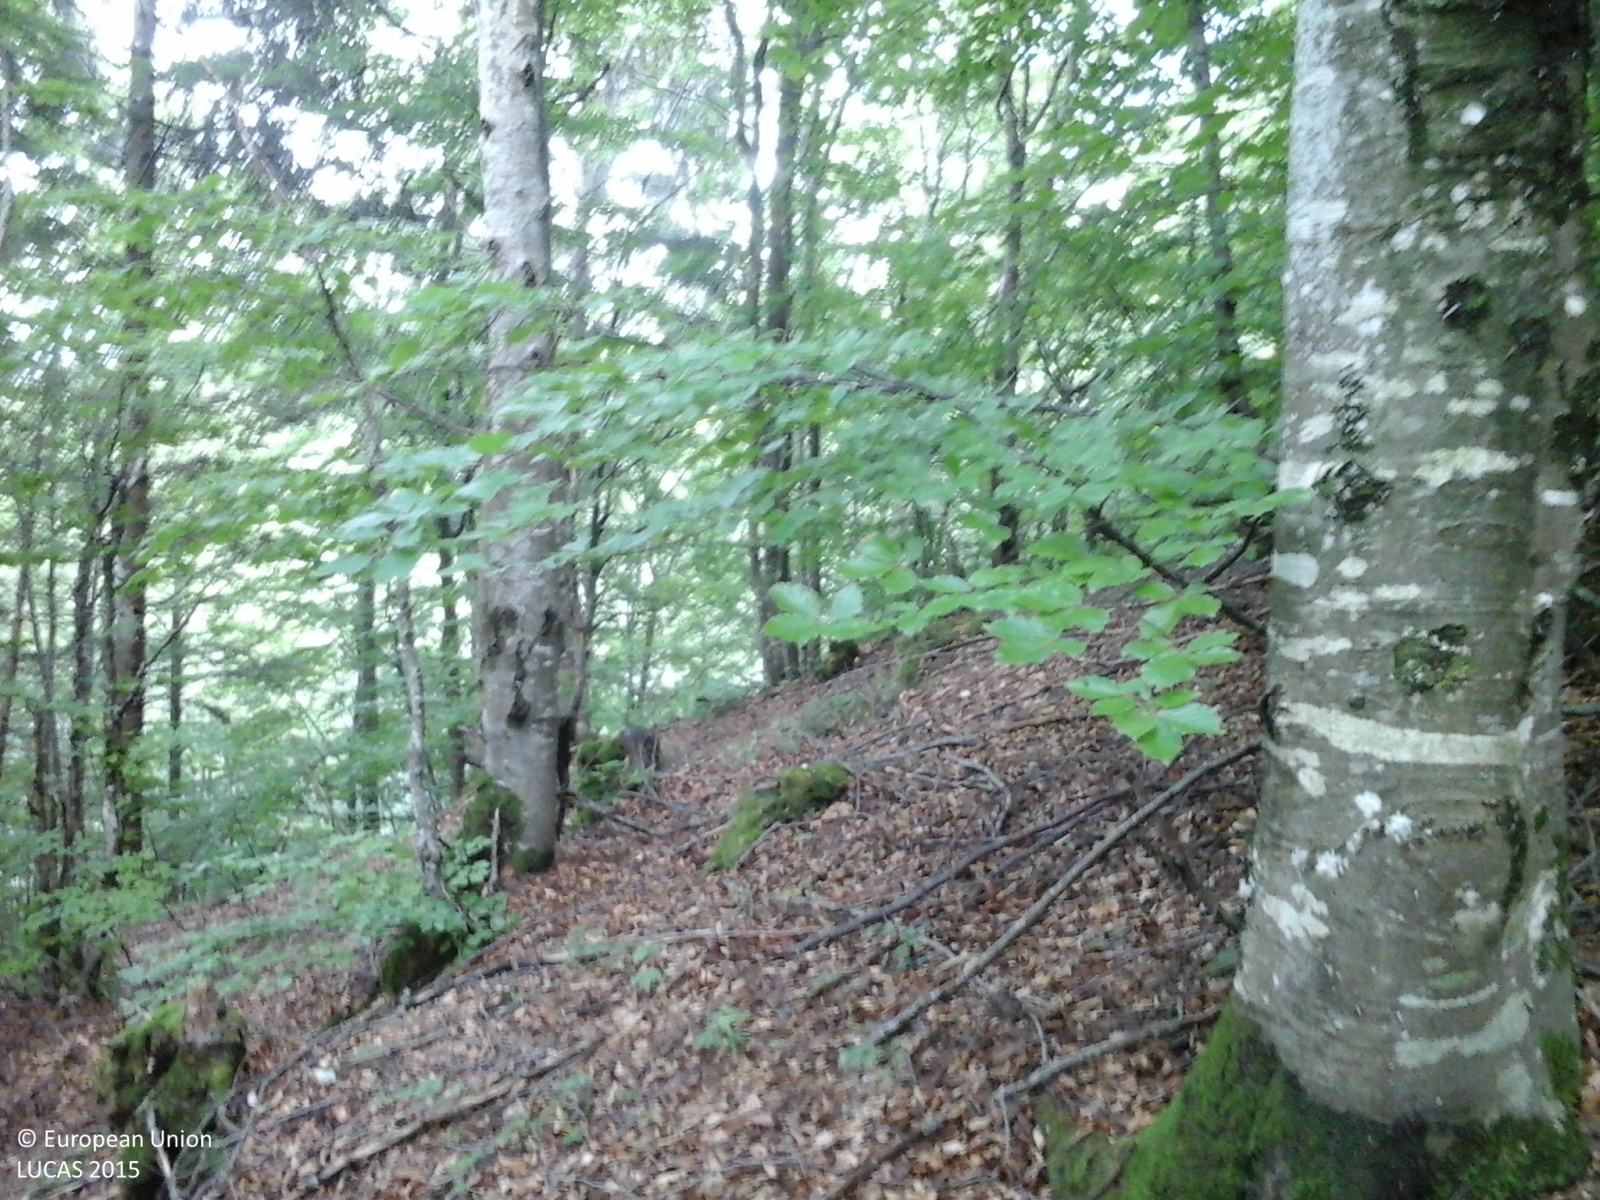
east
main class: Woodland
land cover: Broadleaved woodland
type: mountainous beech forest
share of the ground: > 75 %
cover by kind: broadleaved forest trees 100 %
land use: Forestry
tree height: > 5 m
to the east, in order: Broadleaved woodland; Other mixed woodland; Shrubland with sparse tree cover; Electric lines; Shrubland with sparse tree cover; Other mixed woodland
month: June
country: IT
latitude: 45.8706
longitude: 11.6080
